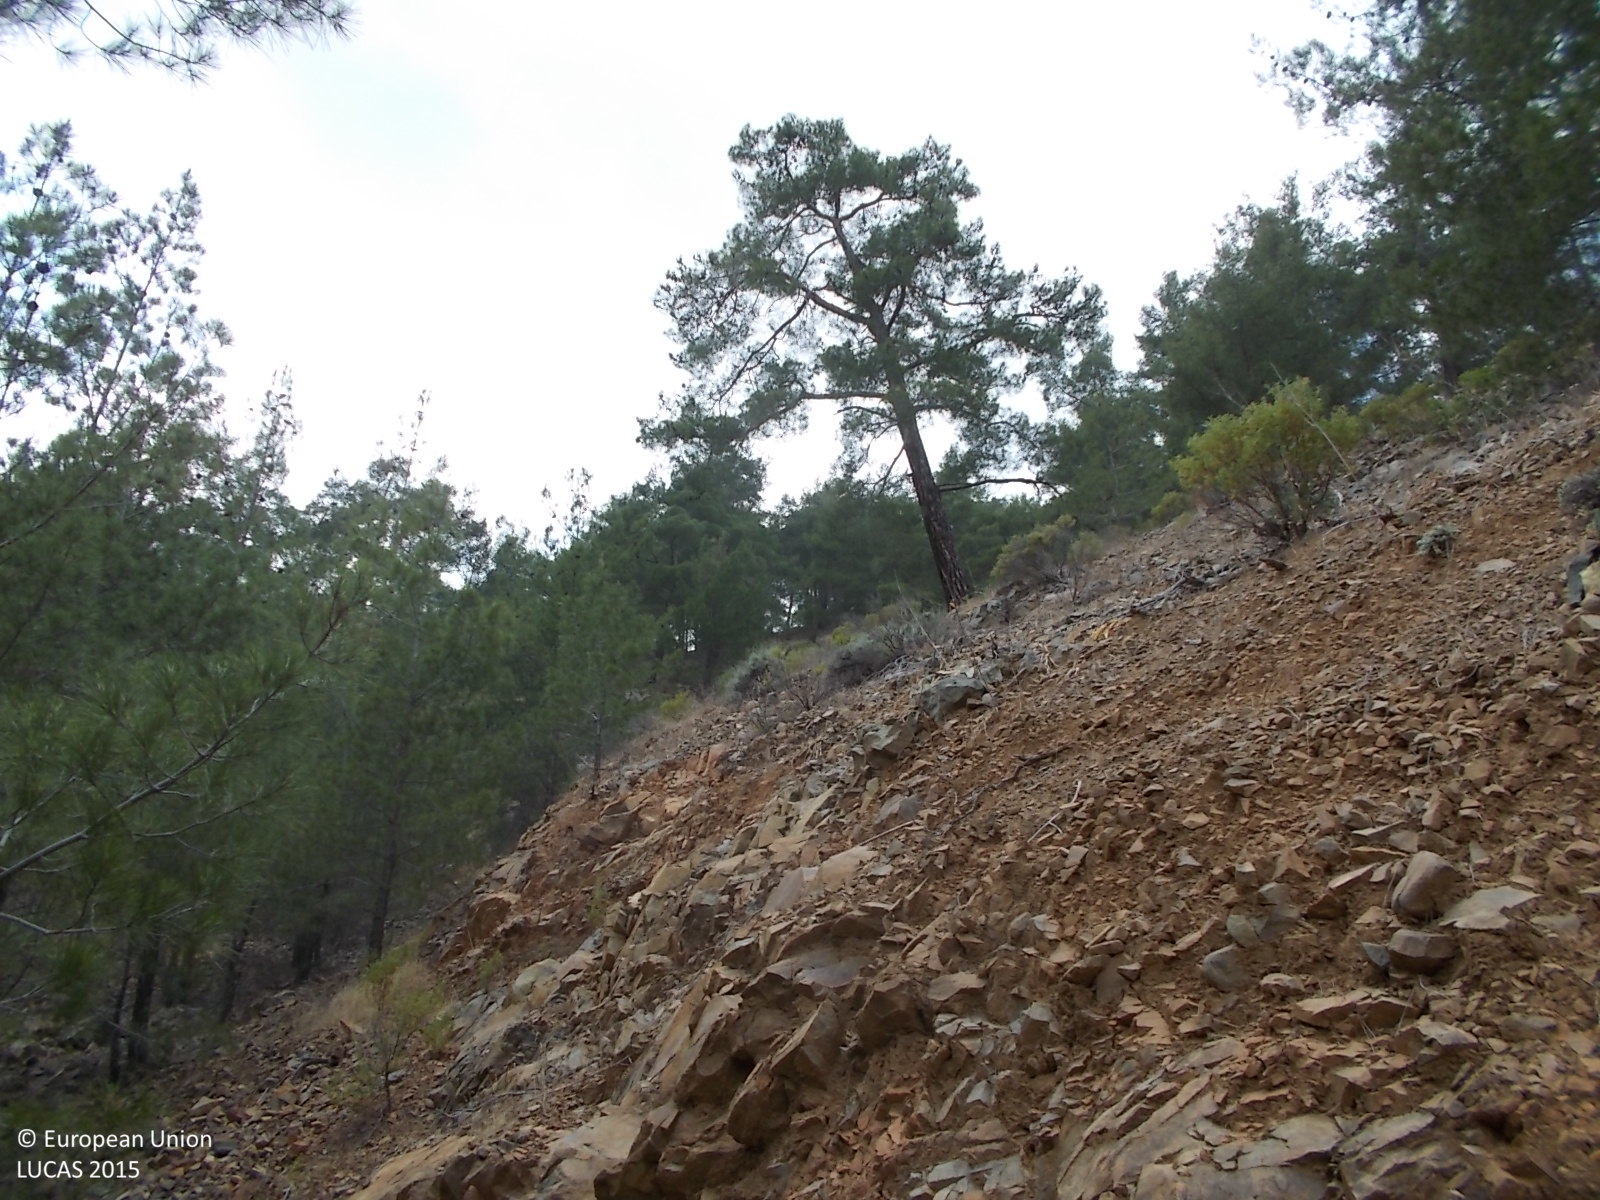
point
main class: Woodland
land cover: Pine dominated coniferous woodland
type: coniferous forest of the mediterranean region
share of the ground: > 75 %
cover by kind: coniferous forest trees 75 %, unconsolidated bare surface 25 %
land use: Forestry
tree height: > 5 m
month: June
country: CY
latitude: 35.0917
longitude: 32.6385
